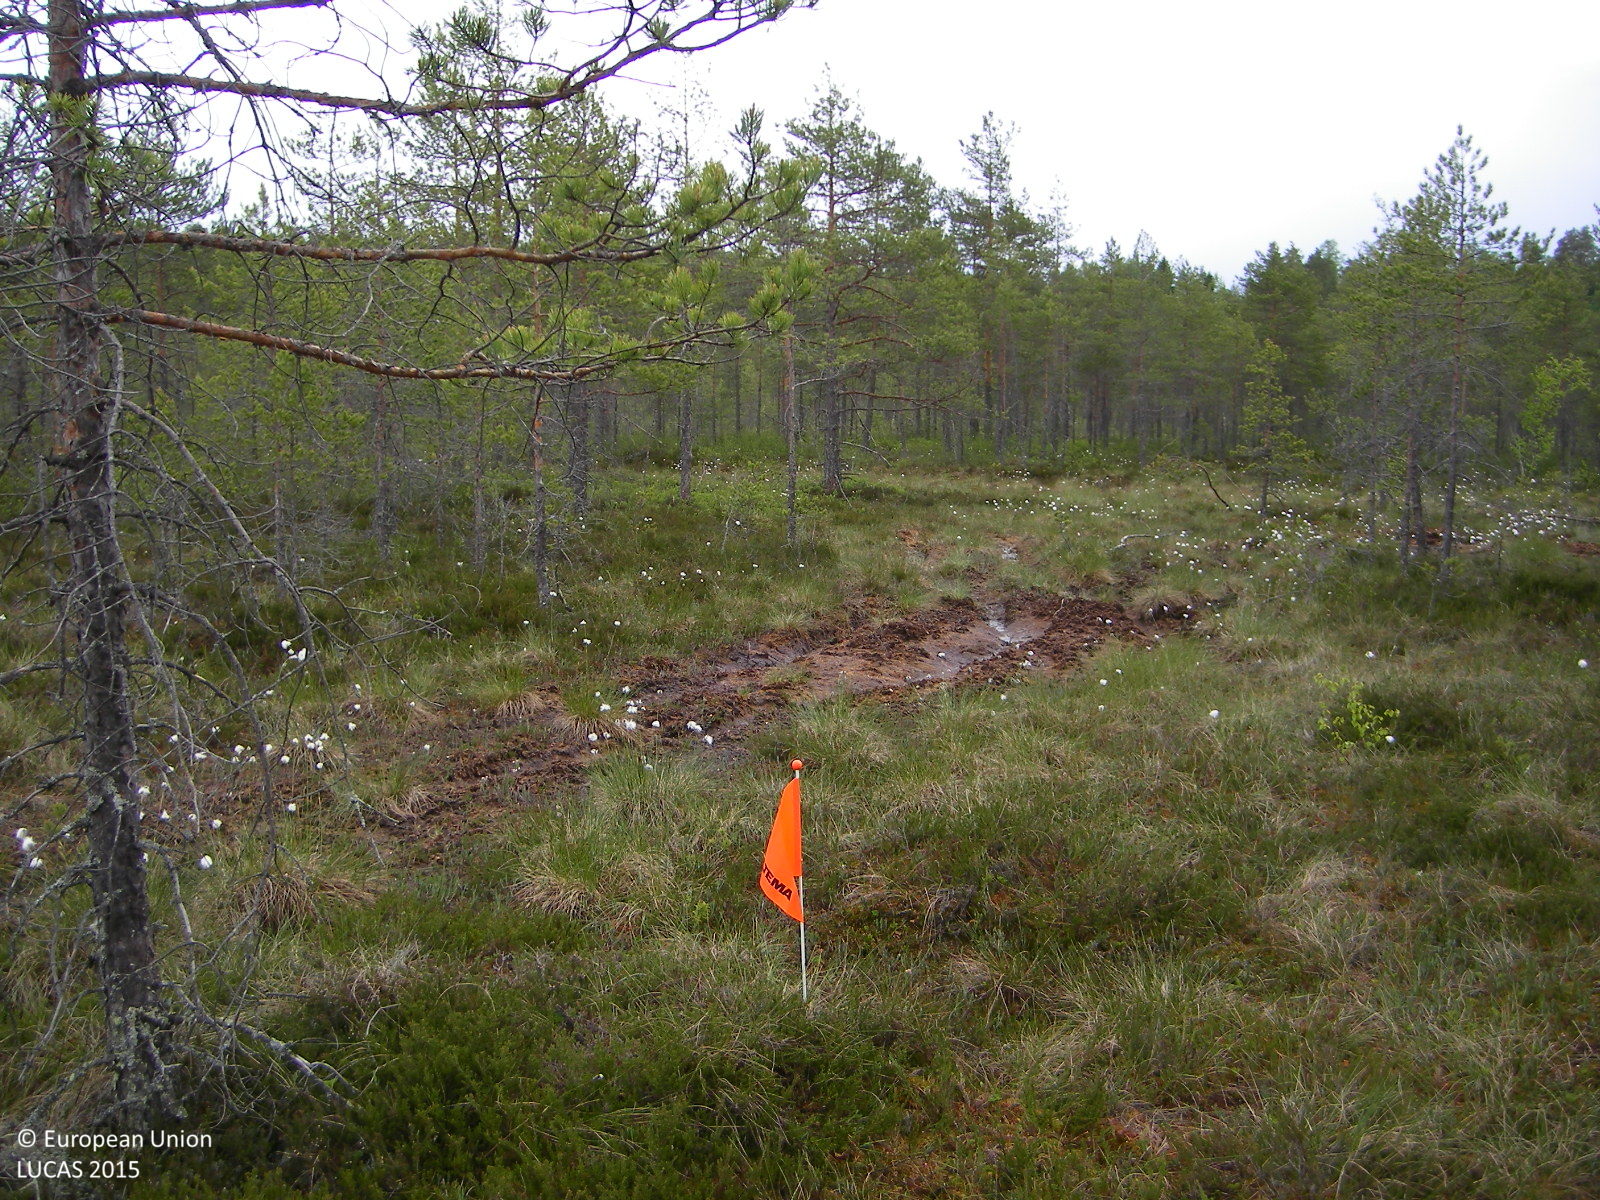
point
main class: Woodland
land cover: Pine dominated coniferous woodland
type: mire and swamp forests
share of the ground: 25 - 50 %
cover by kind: coniferous forest trees 45 %, shrubs 25 %, herbaceous plants 20 %, lichens and mosses 5 %, unconsolidated bare surface 5 %
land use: Semi-natural and natural areas not in use
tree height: < 5 m
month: June
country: FI
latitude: 60.3976
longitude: 24.6842
